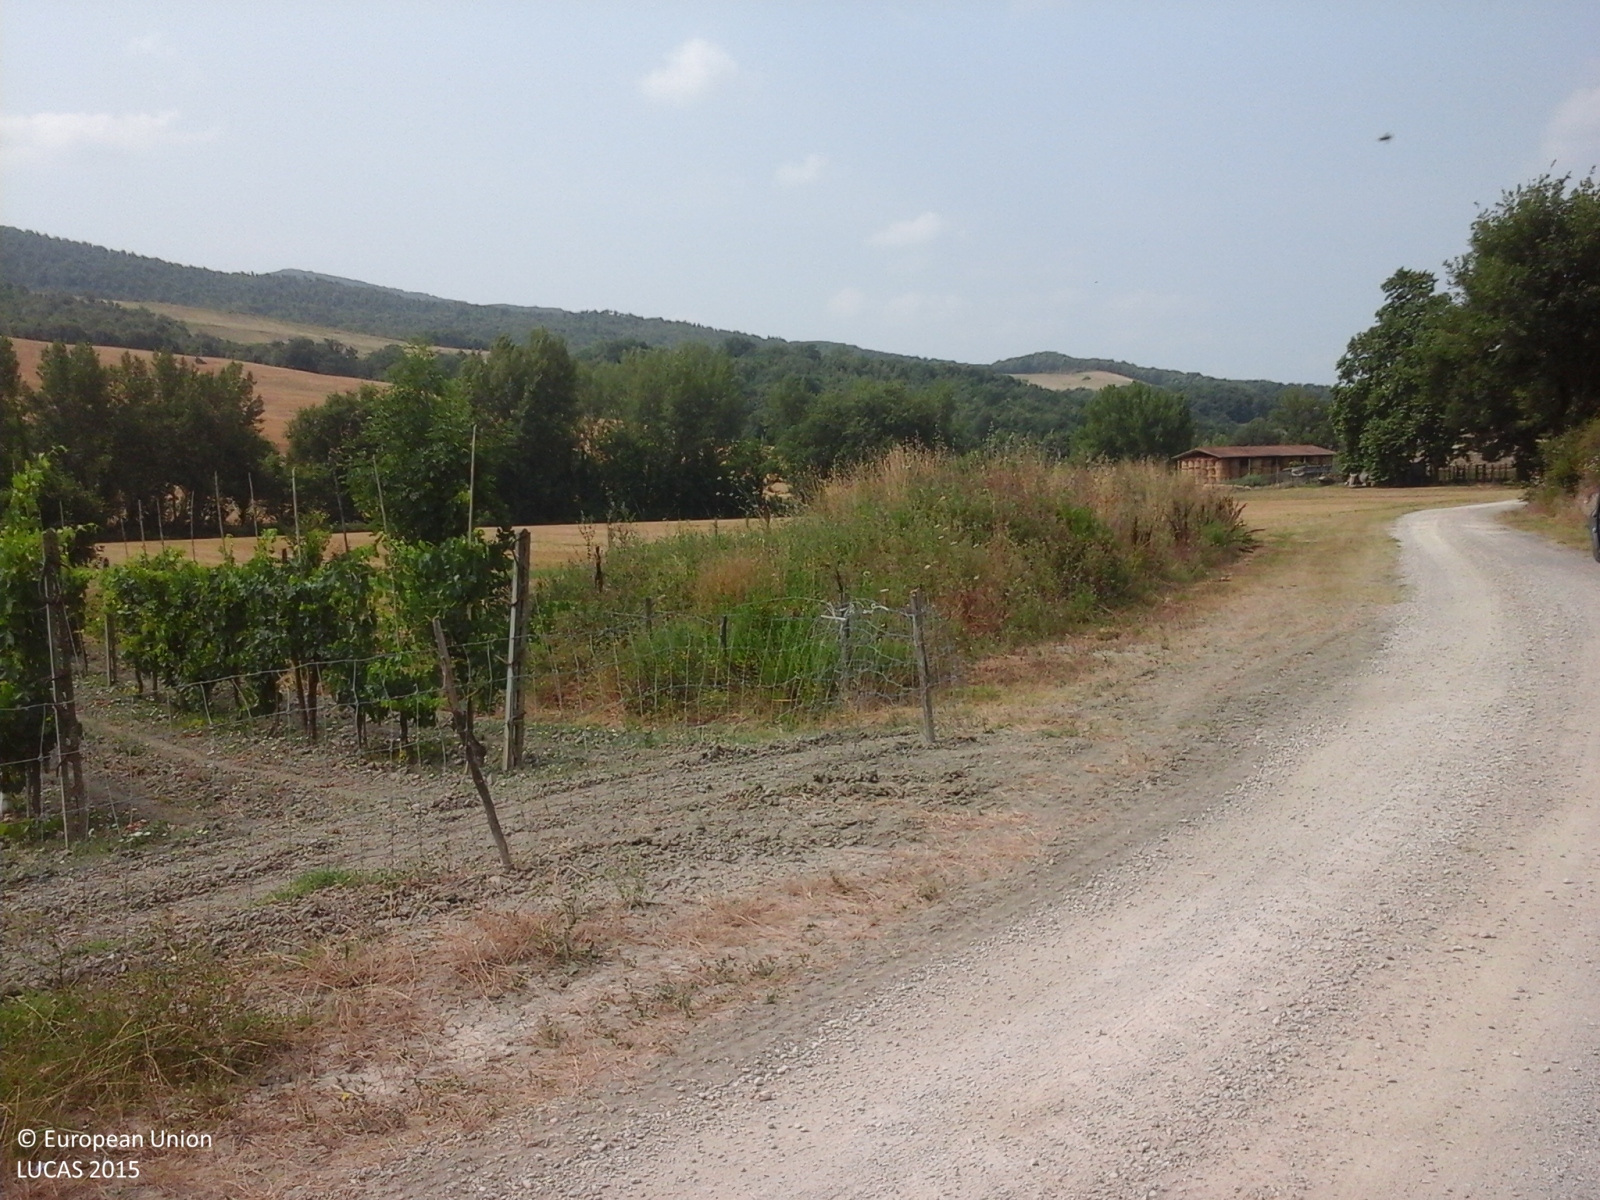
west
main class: Cropland
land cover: Oats
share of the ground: > 75 %
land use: Agriculture (excluding fallow land and kitchen gardens)
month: July
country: IT
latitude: 43.3719
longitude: 10.9475
